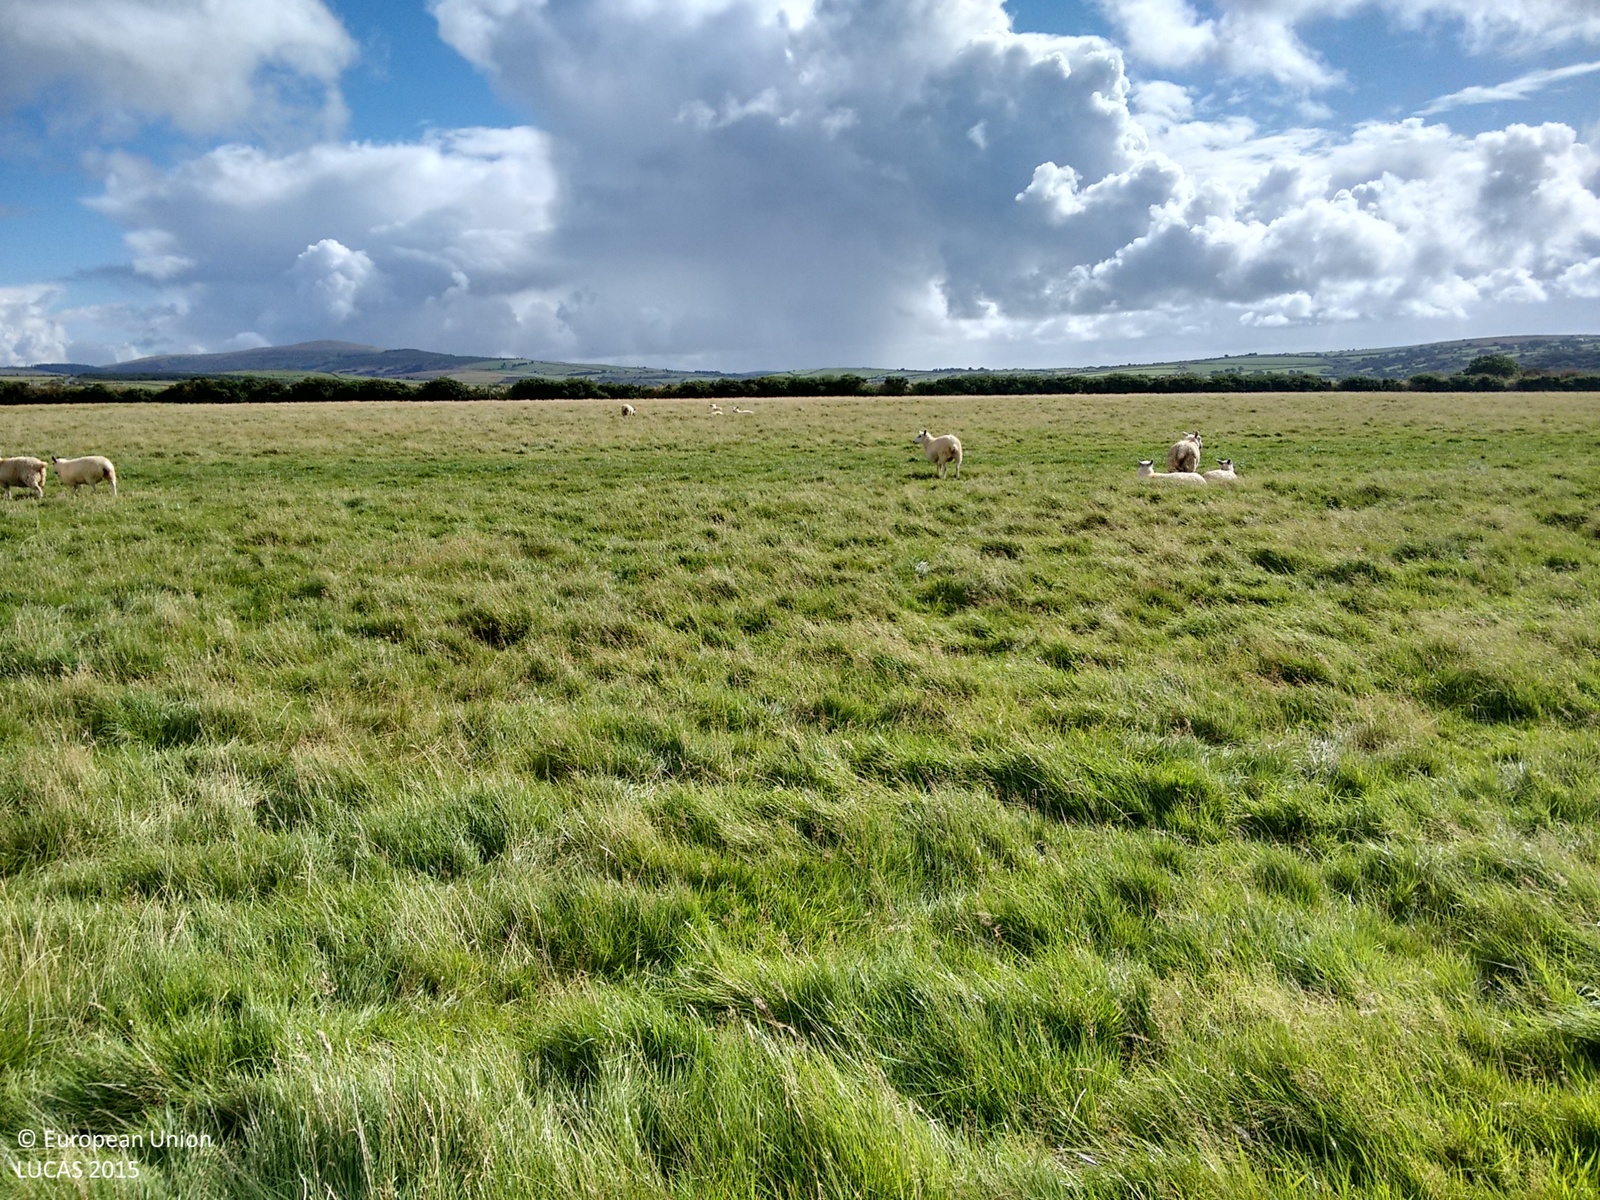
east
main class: Grassland
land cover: Grassland without tree/shrub cover
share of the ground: > 75 %
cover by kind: herbaceous plants 100 %
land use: Agriculture (excluding fallow land and kitchen gardens)
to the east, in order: Grassland without tree/shrub cover; Fences; Managed hedges; Fences; Temporary grasslands
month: August
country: GB
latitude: 51.9095
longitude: -4.8685
